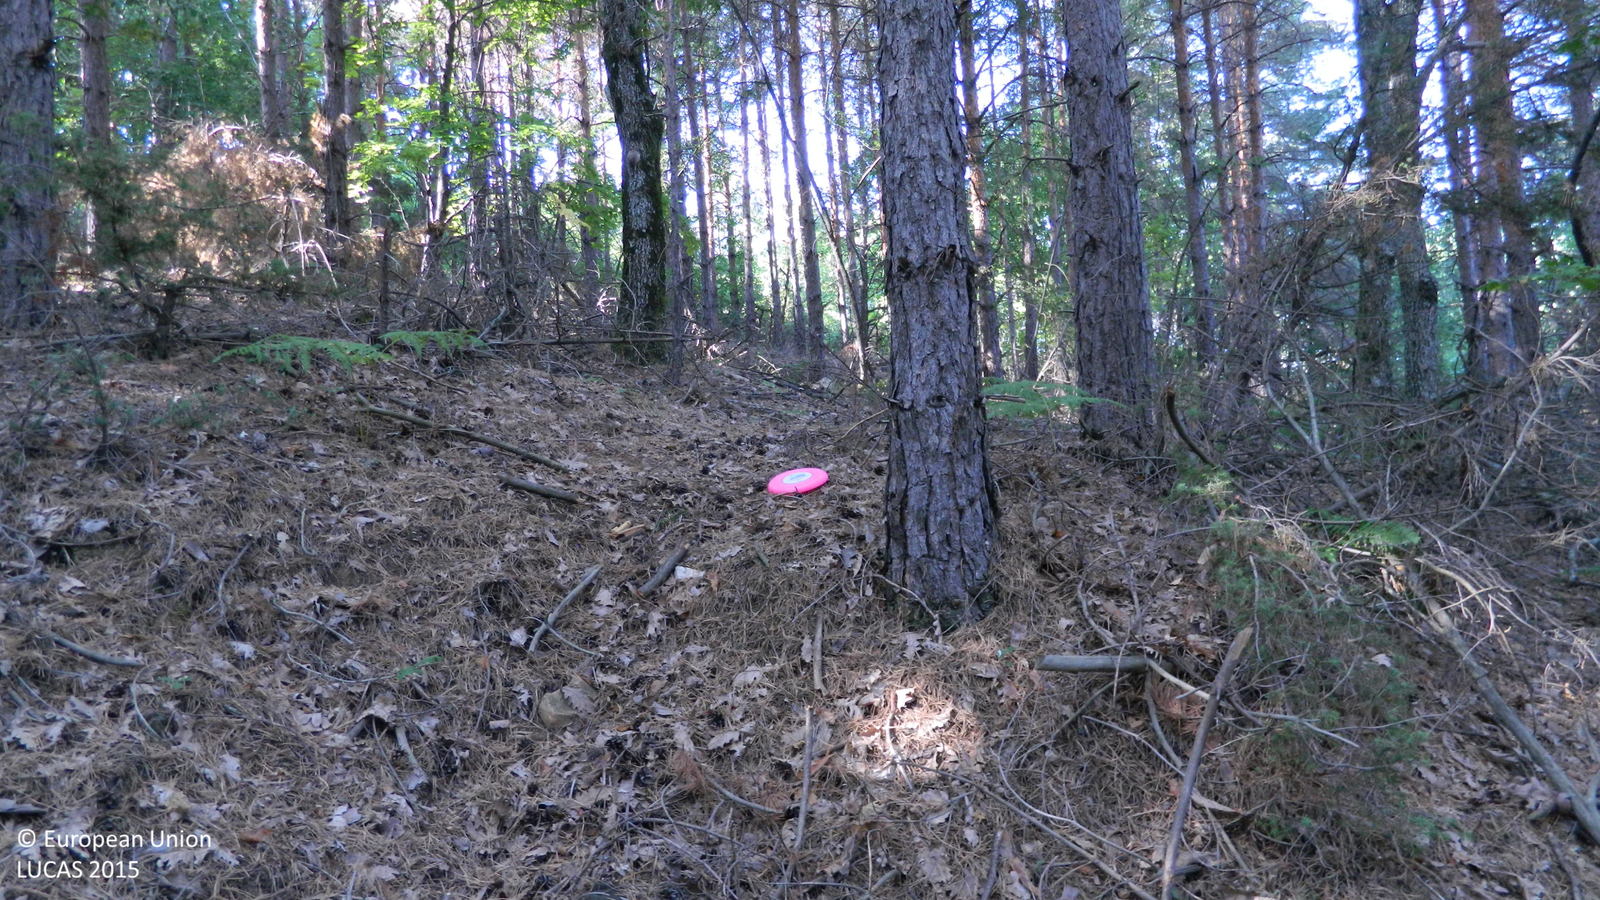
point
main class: Woodland
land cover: Pine dominated mixed woodland
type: hemiboreal forest and nemoral coniferous forest and mixed broadleaved-coniferous forest
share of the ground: > 75 %
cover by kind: coniferous forest trees 75 %, broadleaved forest trees 25 %
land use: Forestry
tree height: > 5 m
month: August
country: BG
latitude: 41.5571
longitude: 25.8808
